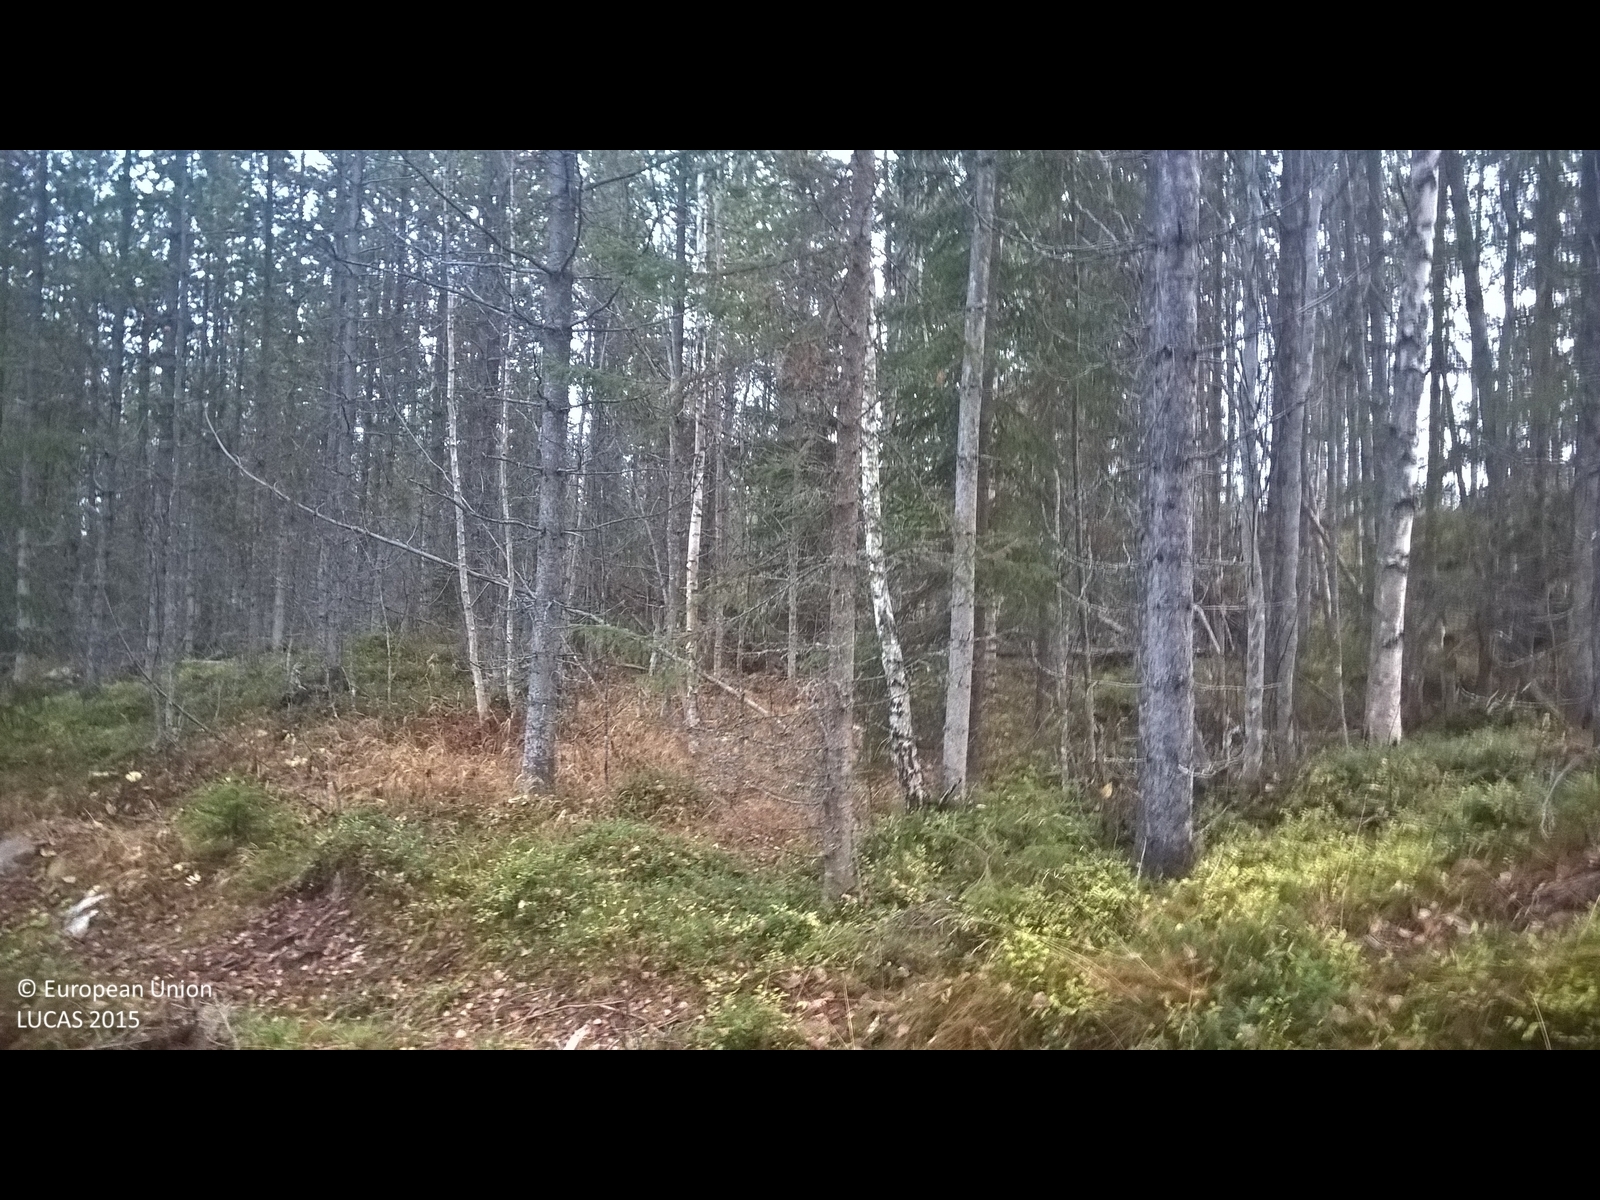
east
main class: Woodland
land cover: Pine dominated coniferous woodland
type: exotic forest
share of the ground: > 75 %
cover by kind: coniferous forest trees 75 %, lichens and mosses 25 %
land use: Forestry
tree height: > 5 m
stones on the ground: < 10 %
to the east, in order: Pine dominated coniferous woodland; Other mixed woodland
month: October
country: SE
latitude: 63.0614
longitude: 15.2998
